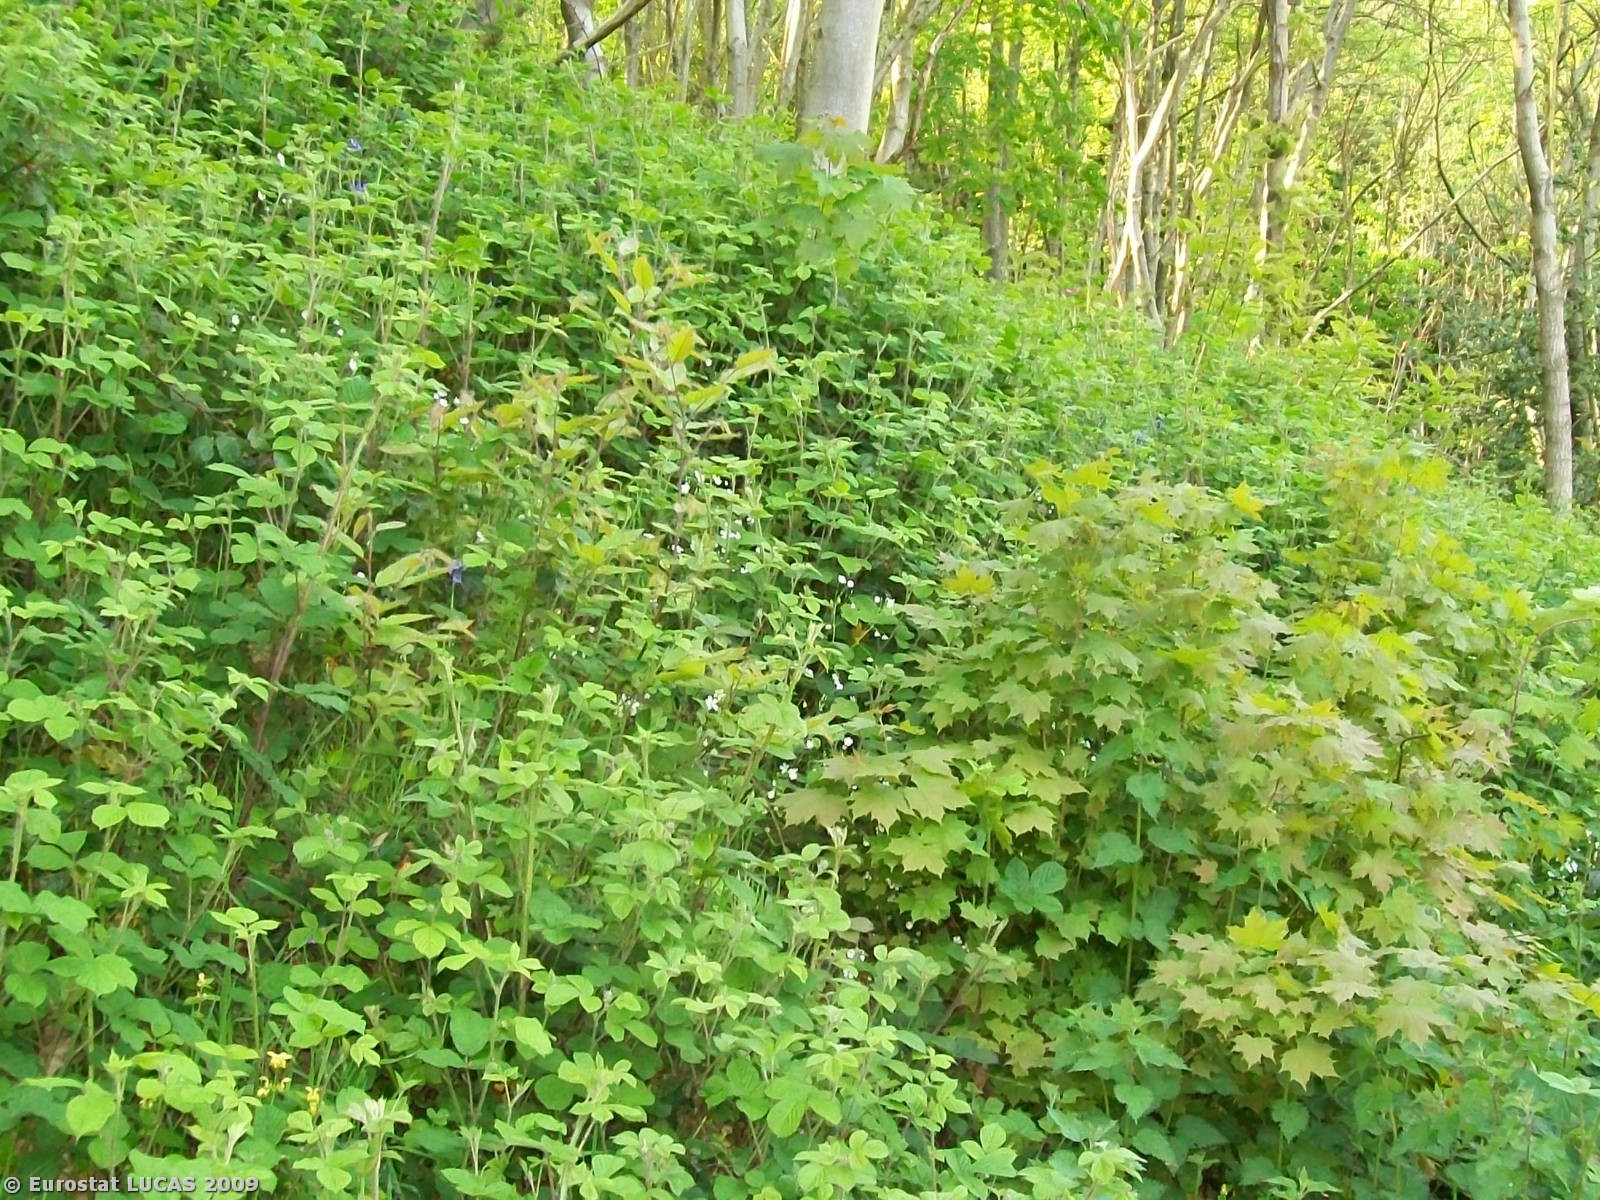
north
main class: Cropland
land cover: Maize
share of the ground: < 10 %
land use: Agriculture (excluding fallow land and kitchen gardens)
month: May
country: GB
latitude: 52.3505
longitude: -2.5011
